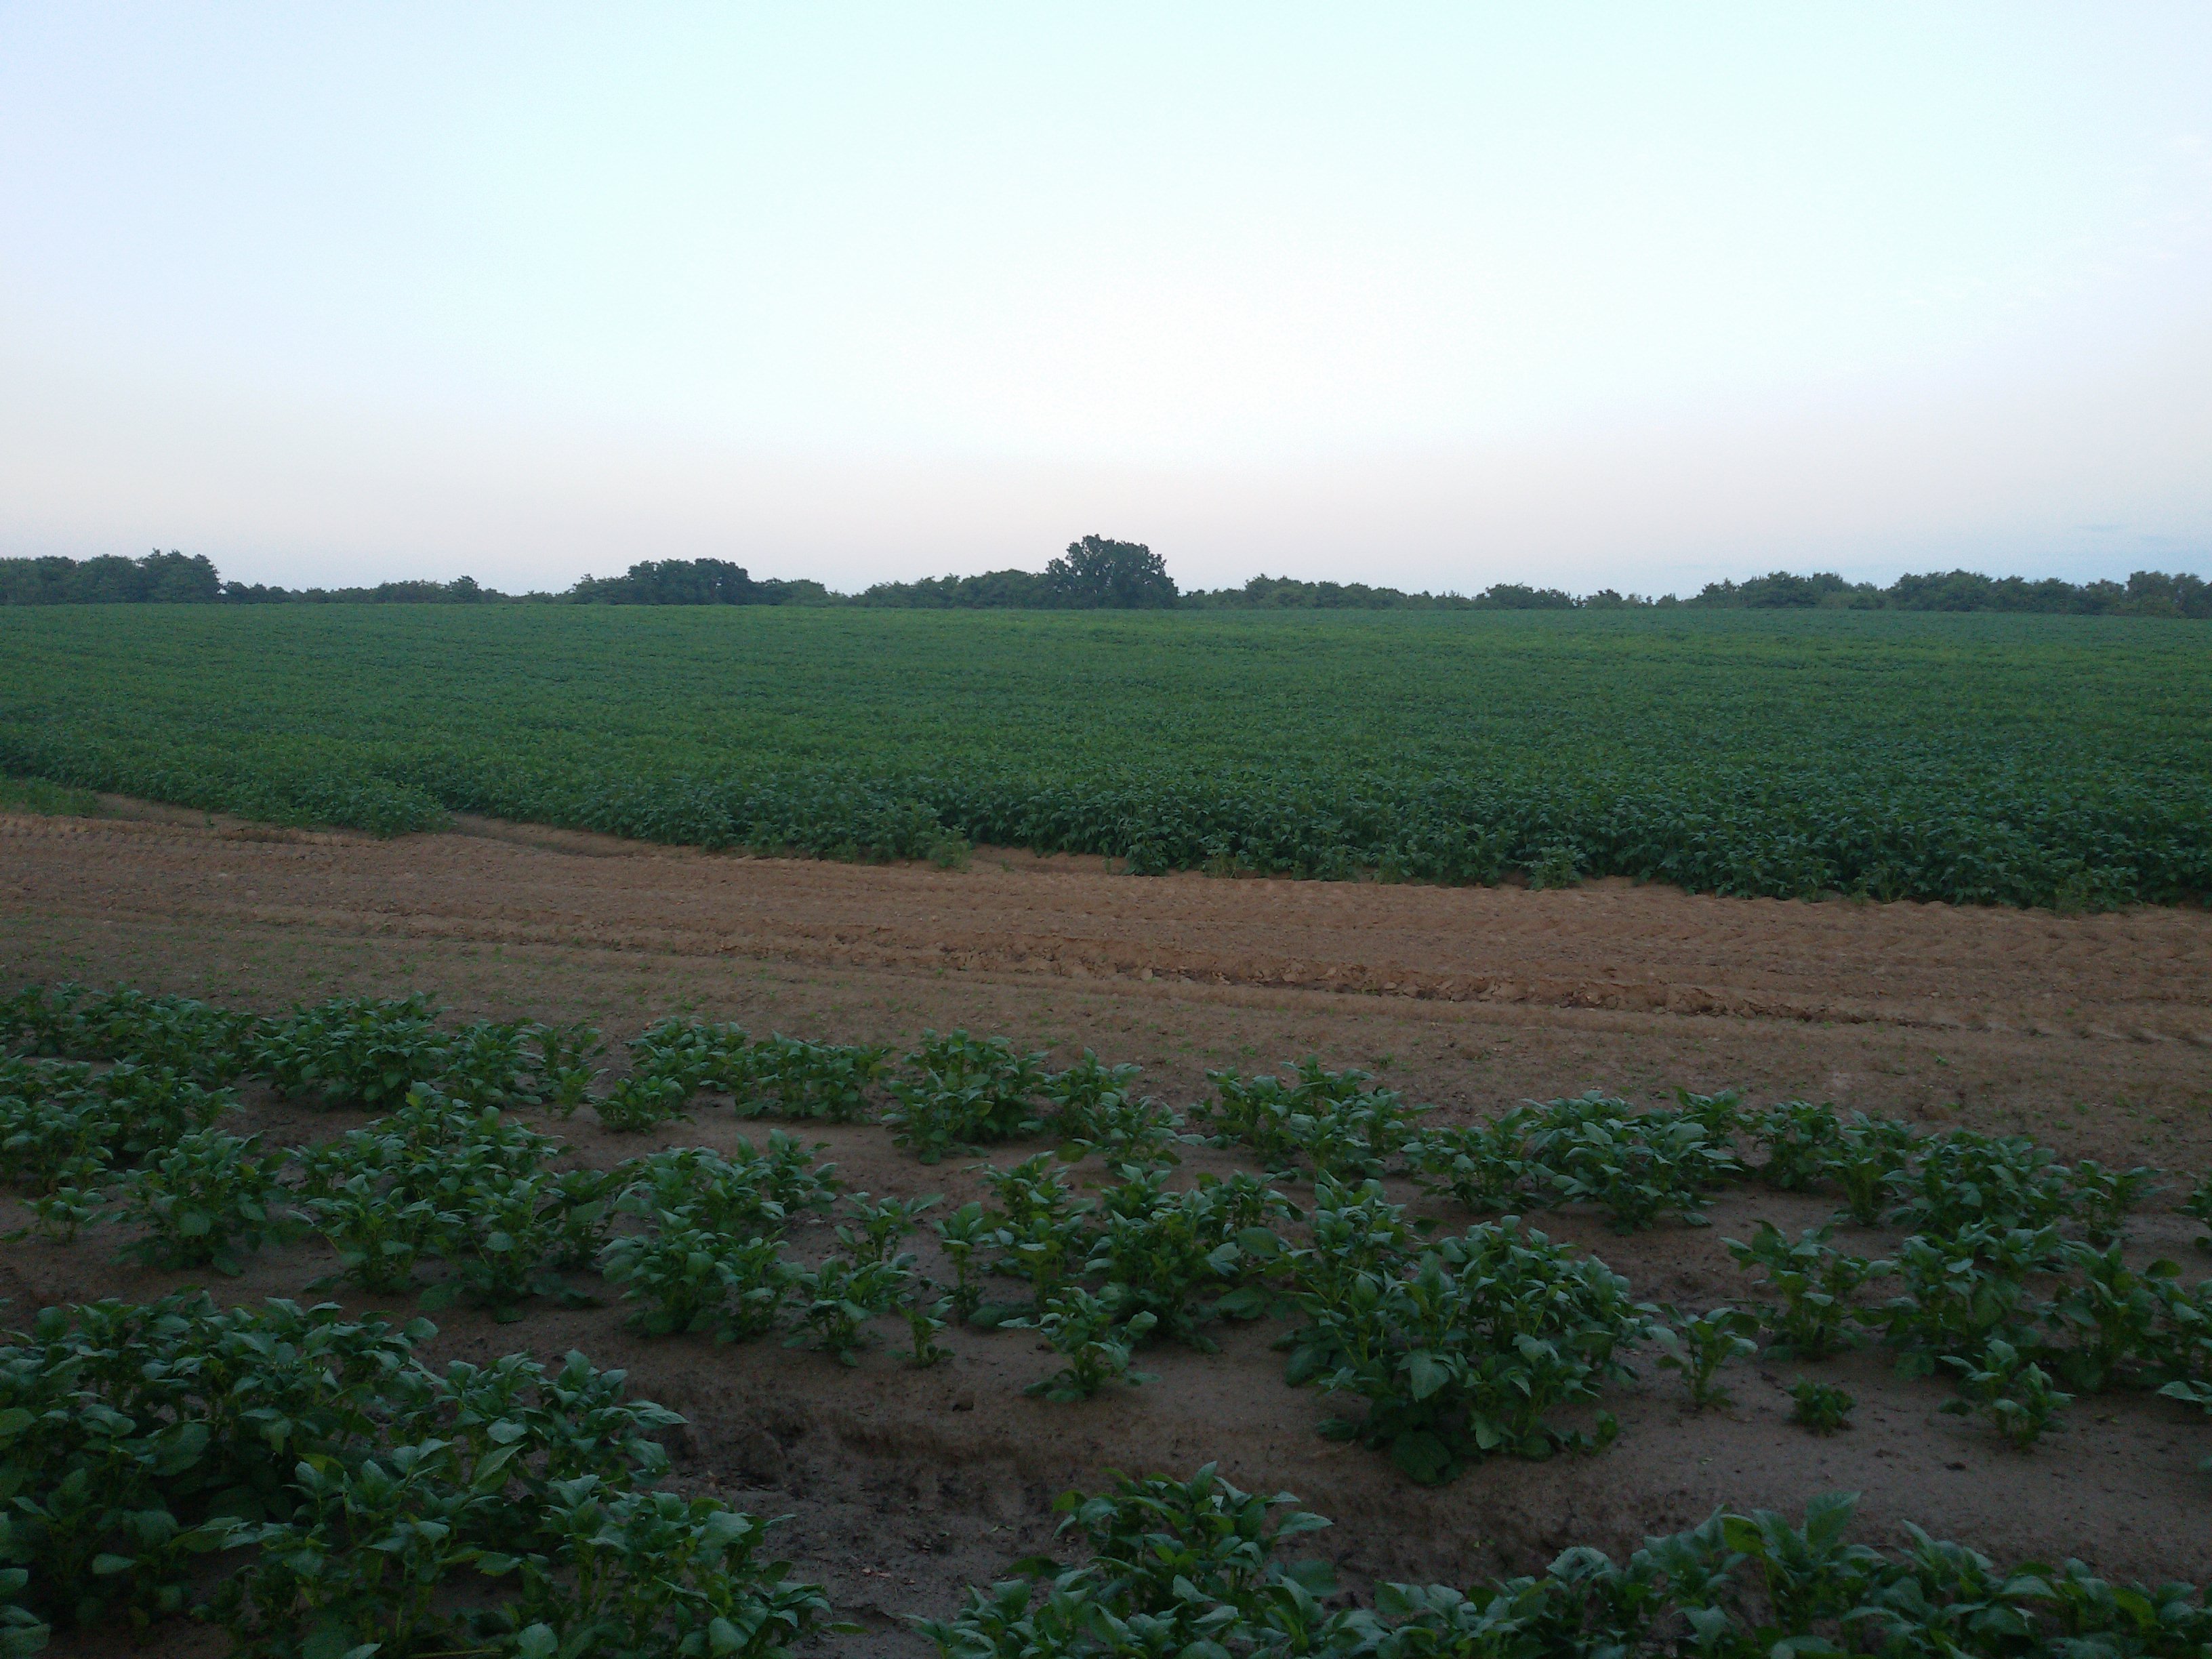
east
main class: Cropland
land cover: Tobacco
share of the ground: > 75 %
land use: Agriculture (excluding fallow land and kitchen gardens)
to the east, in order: Tobacco
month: July
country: PL
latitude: 54.0176
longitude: 15.8493
